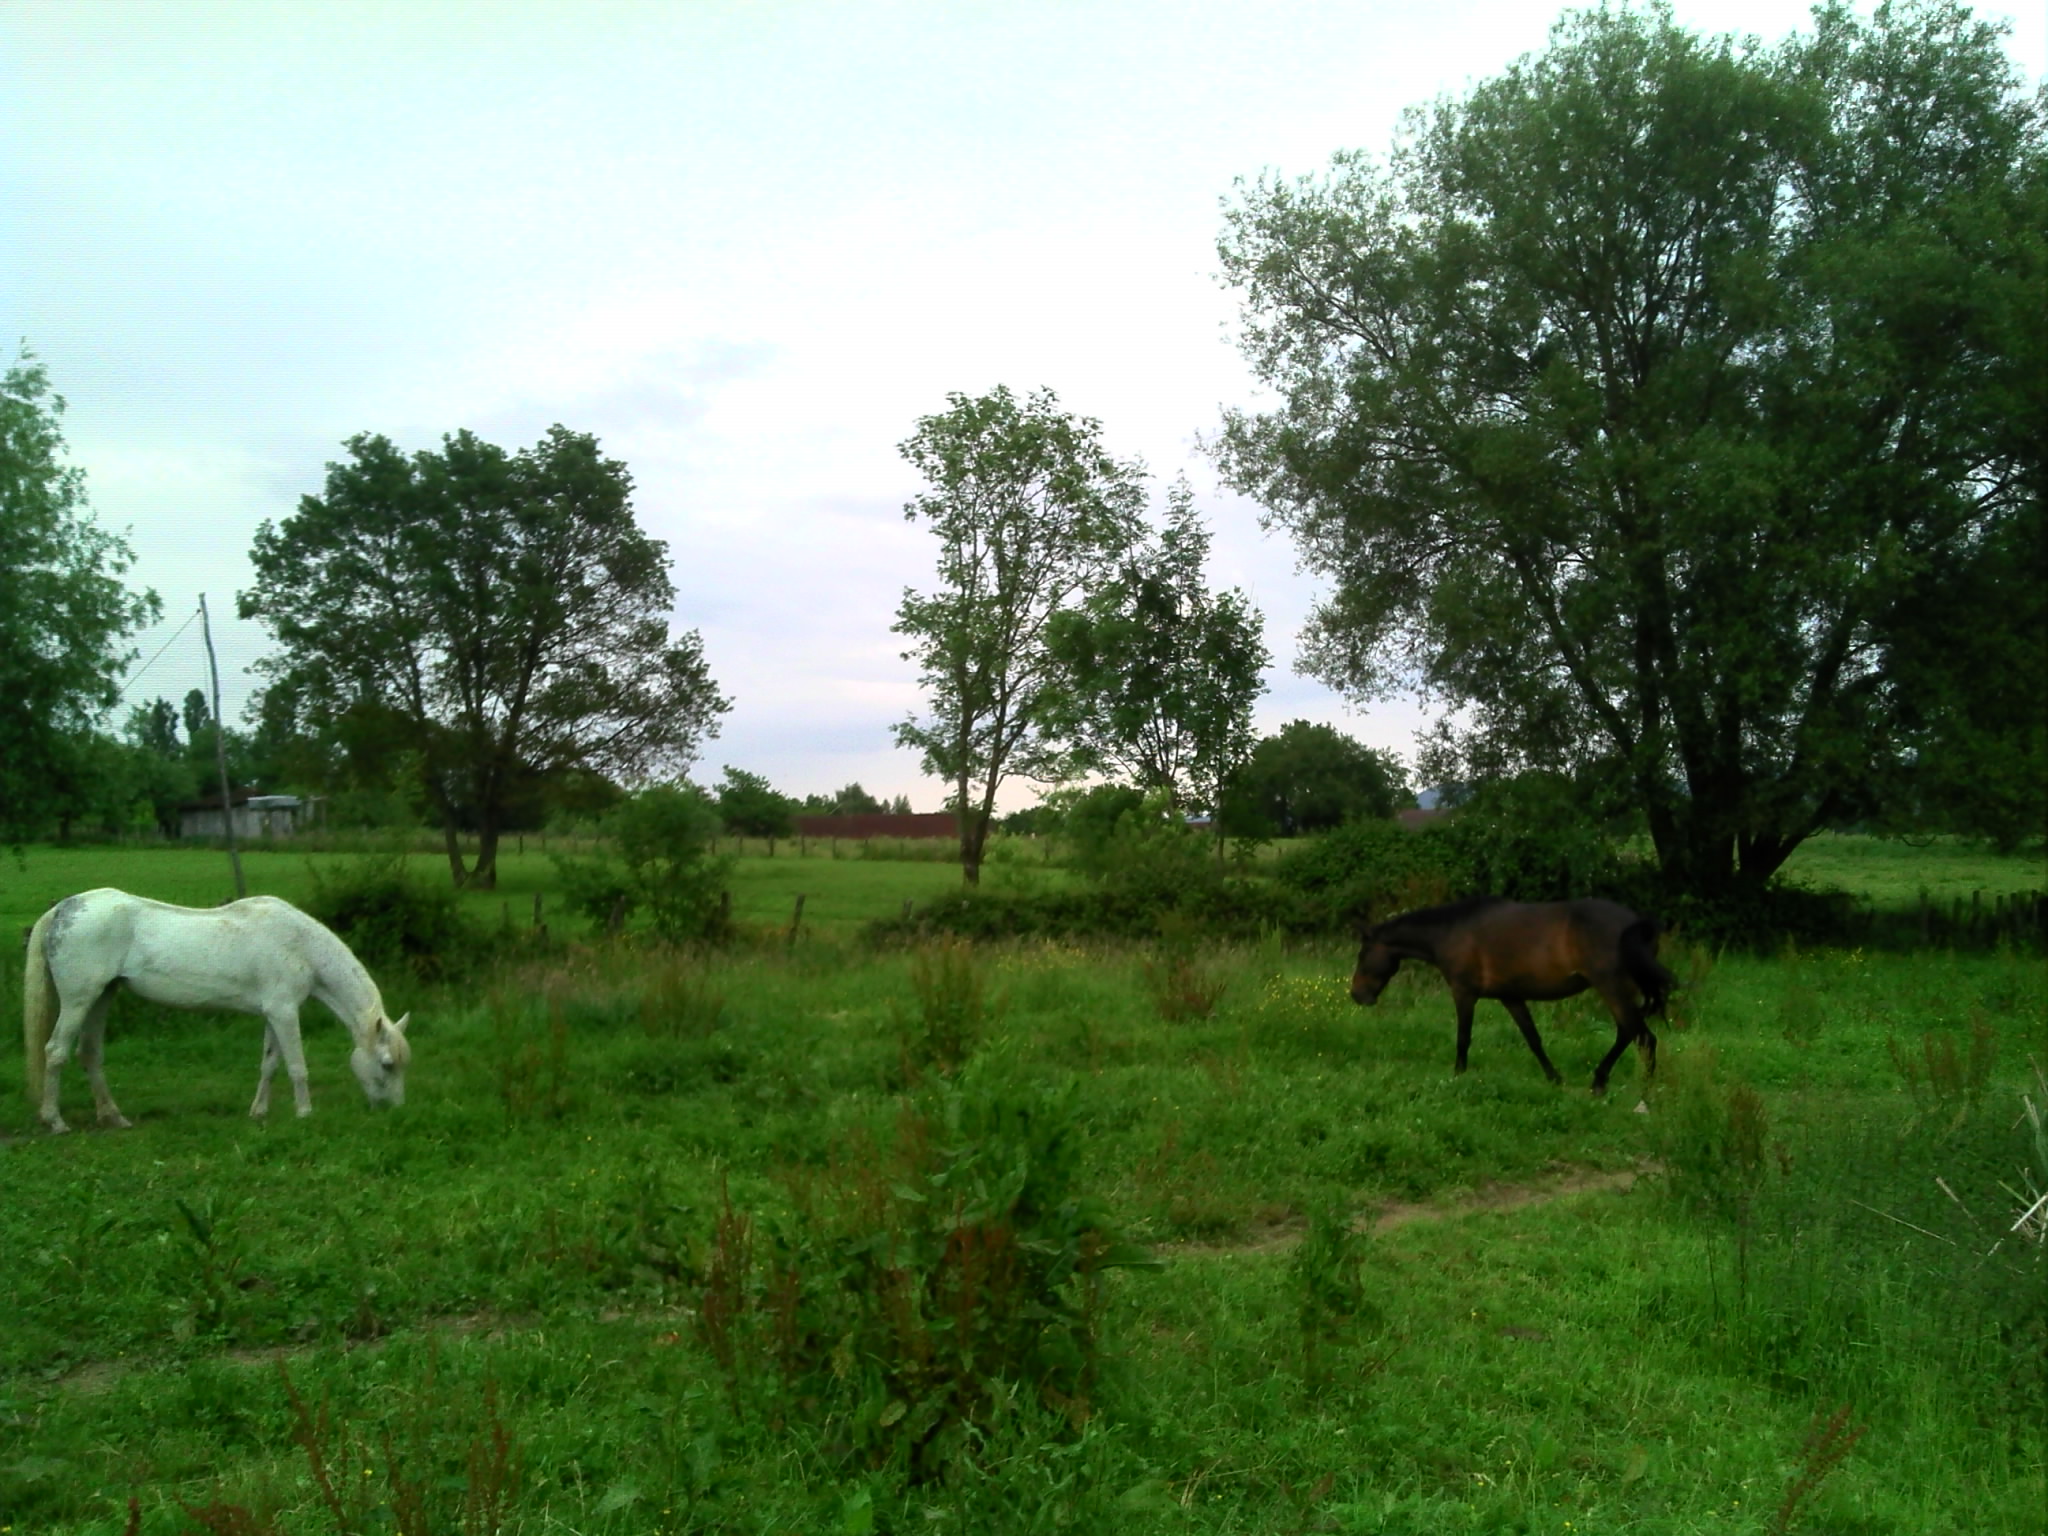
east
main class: Grassland
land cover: Grassland with sparse tree/shrub cover
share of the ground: > 75 %
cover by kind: herbaceous plants 95 %, broadleaved forest trees 5 %
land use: Agriculture (excluding fallow land and kitchen gardens)
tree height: < 5 m
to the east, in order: Grassland with sparse tree/shrub cover; Fences; Grassland with sparse tree/shrub cover; Fences; Grassland without tree/shrub cover; Broadleaved woodland; Grassland without tree/shrub cover; Fences
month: May
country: FR
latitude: 46.5948
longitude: 5.3947
